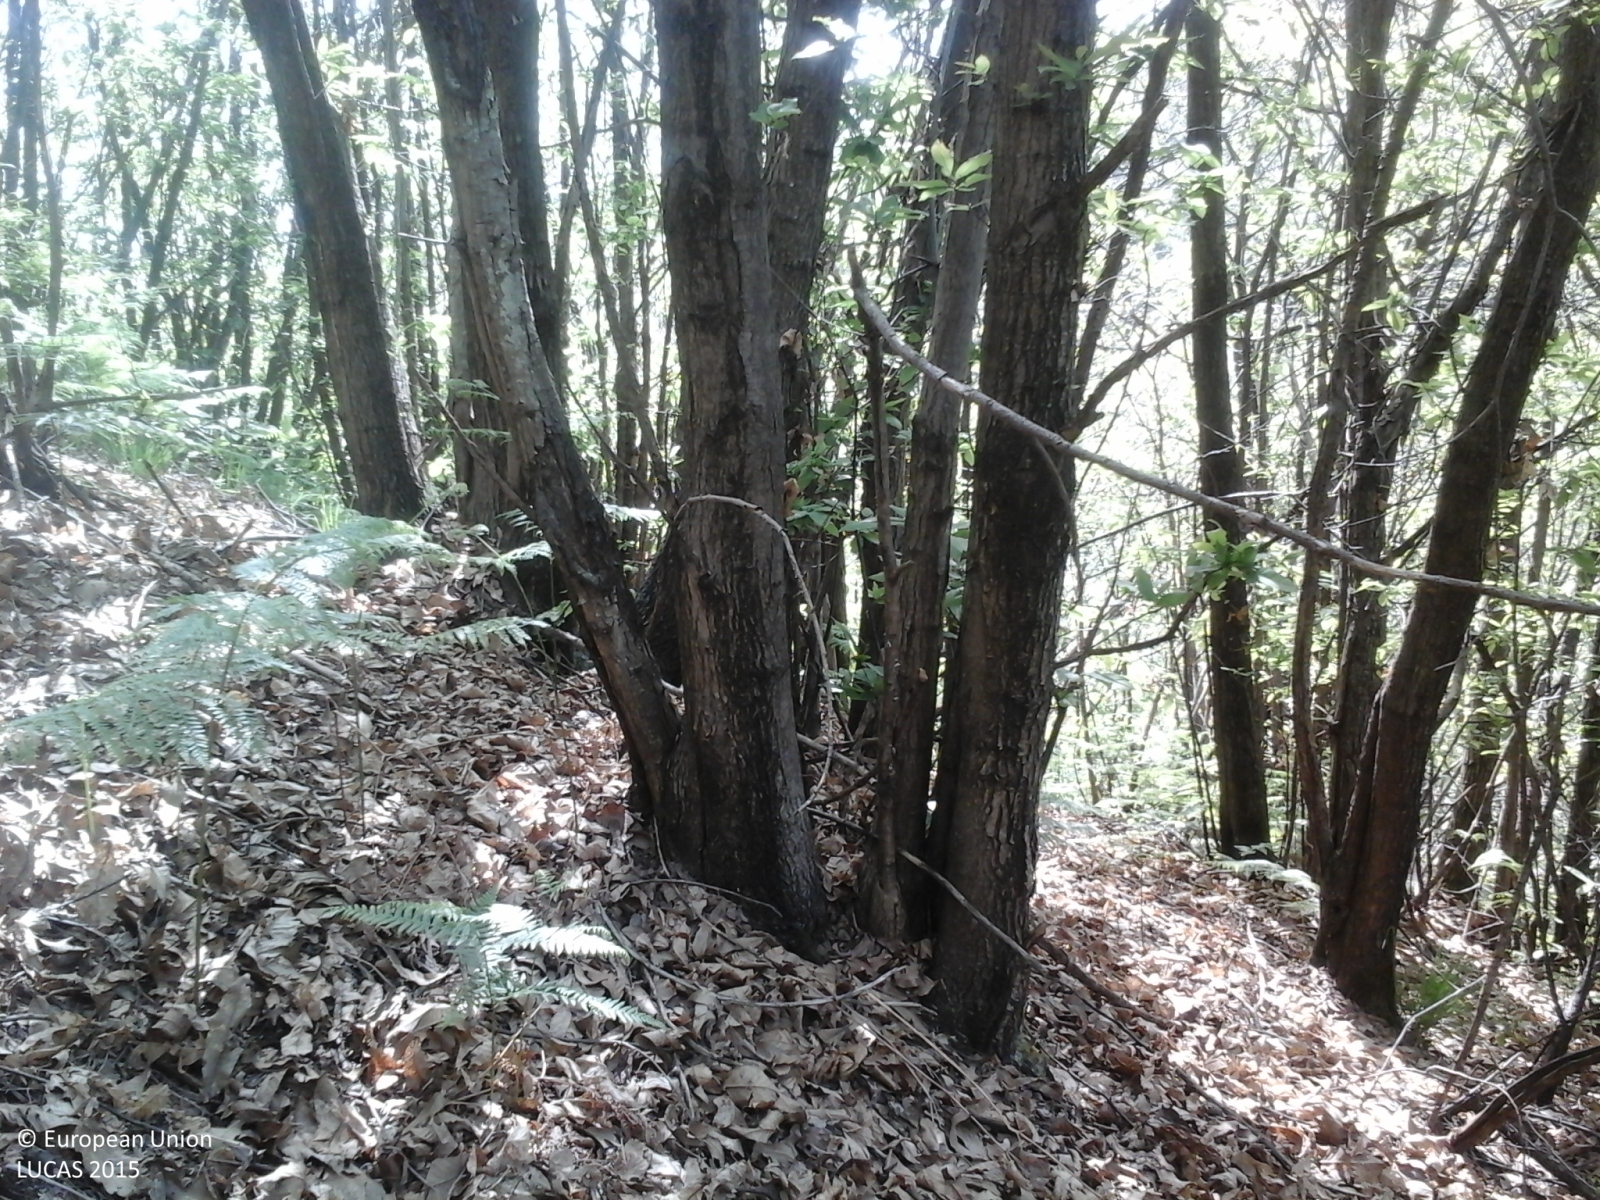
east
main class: Woodland
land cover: Broadleaved woodland
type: thermophilous deciduous forest
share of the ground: > 75 %
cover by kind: broadleaved forest trees 100 %
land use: Forestry
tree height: > 5 m
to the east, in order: Broadleaved woodland; Paved roads, cycling and walking lanes; Broadleaved woodland; Rivers and streams; Broadleaved woodland
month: May
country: IT
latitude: 45.7442
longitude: 8.3701
